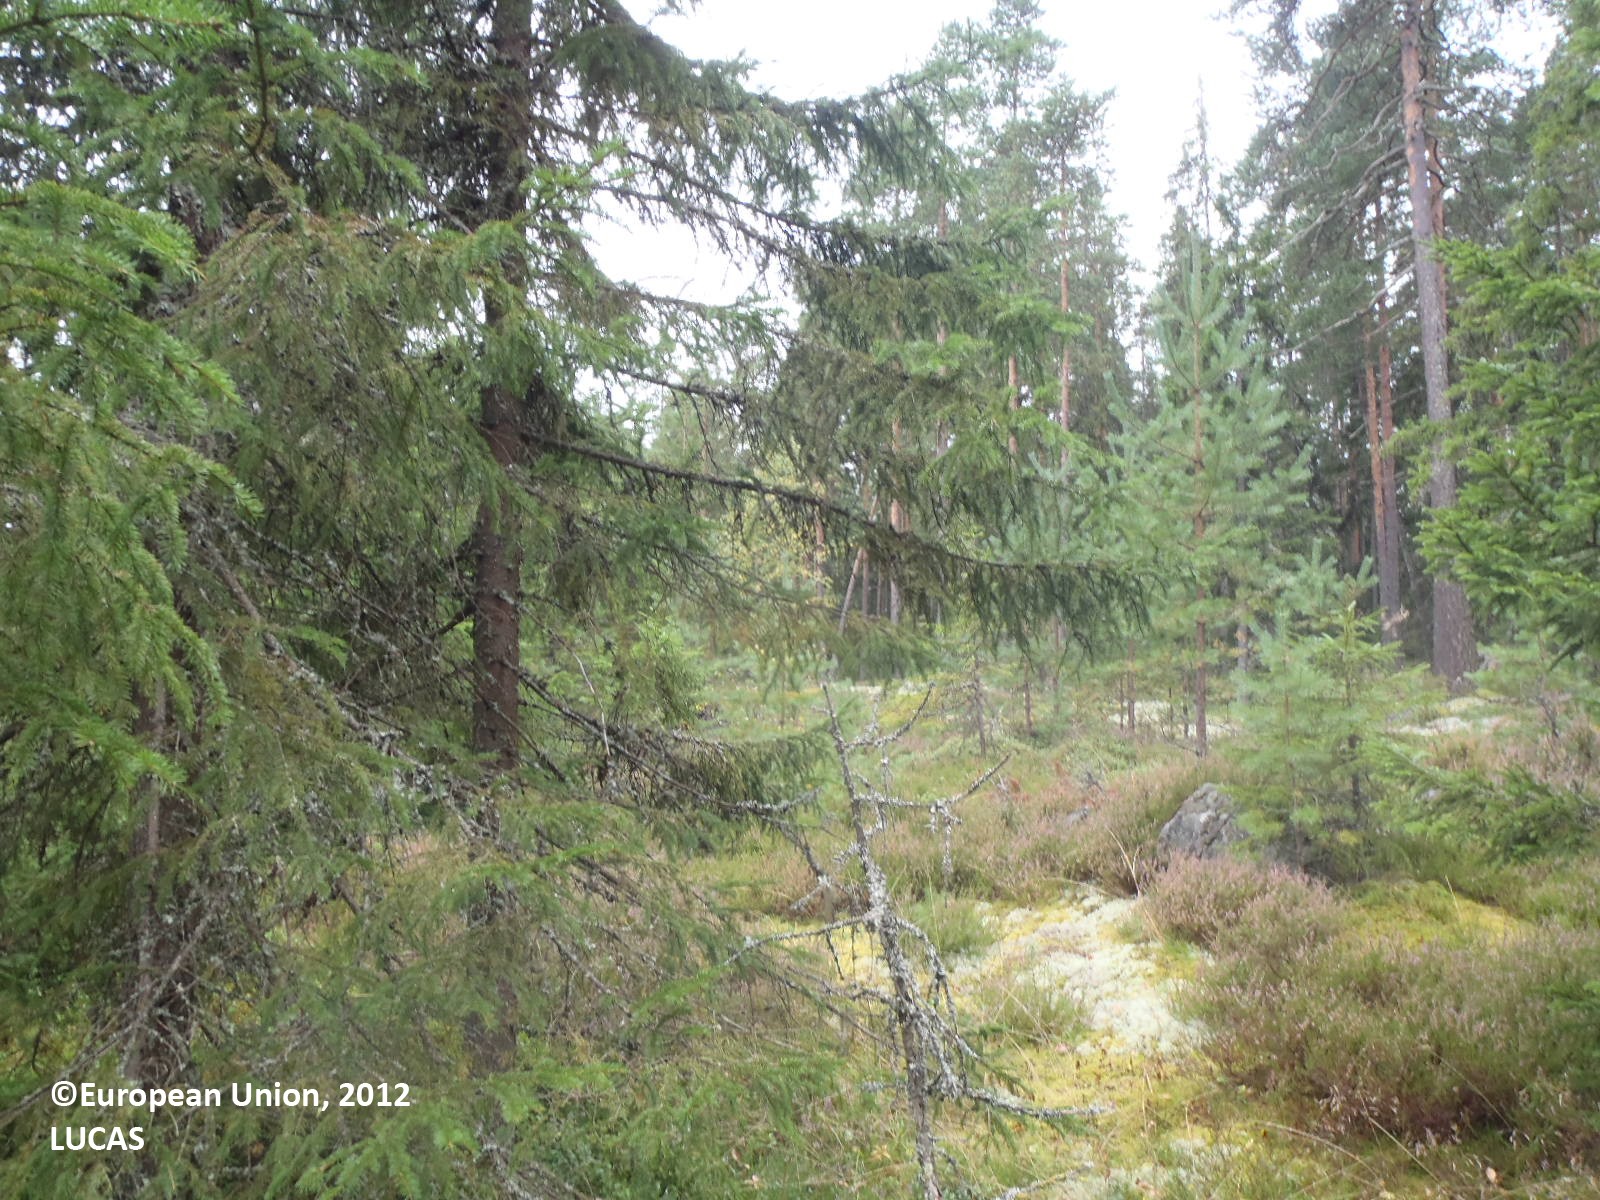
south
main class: Woodland
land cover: Other mixed woodland
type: boreal forest
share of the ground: 50 - 75 %
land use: Forestry
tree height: > 5 m
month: September
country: FI
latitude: 60.7327
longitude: 22.7433
